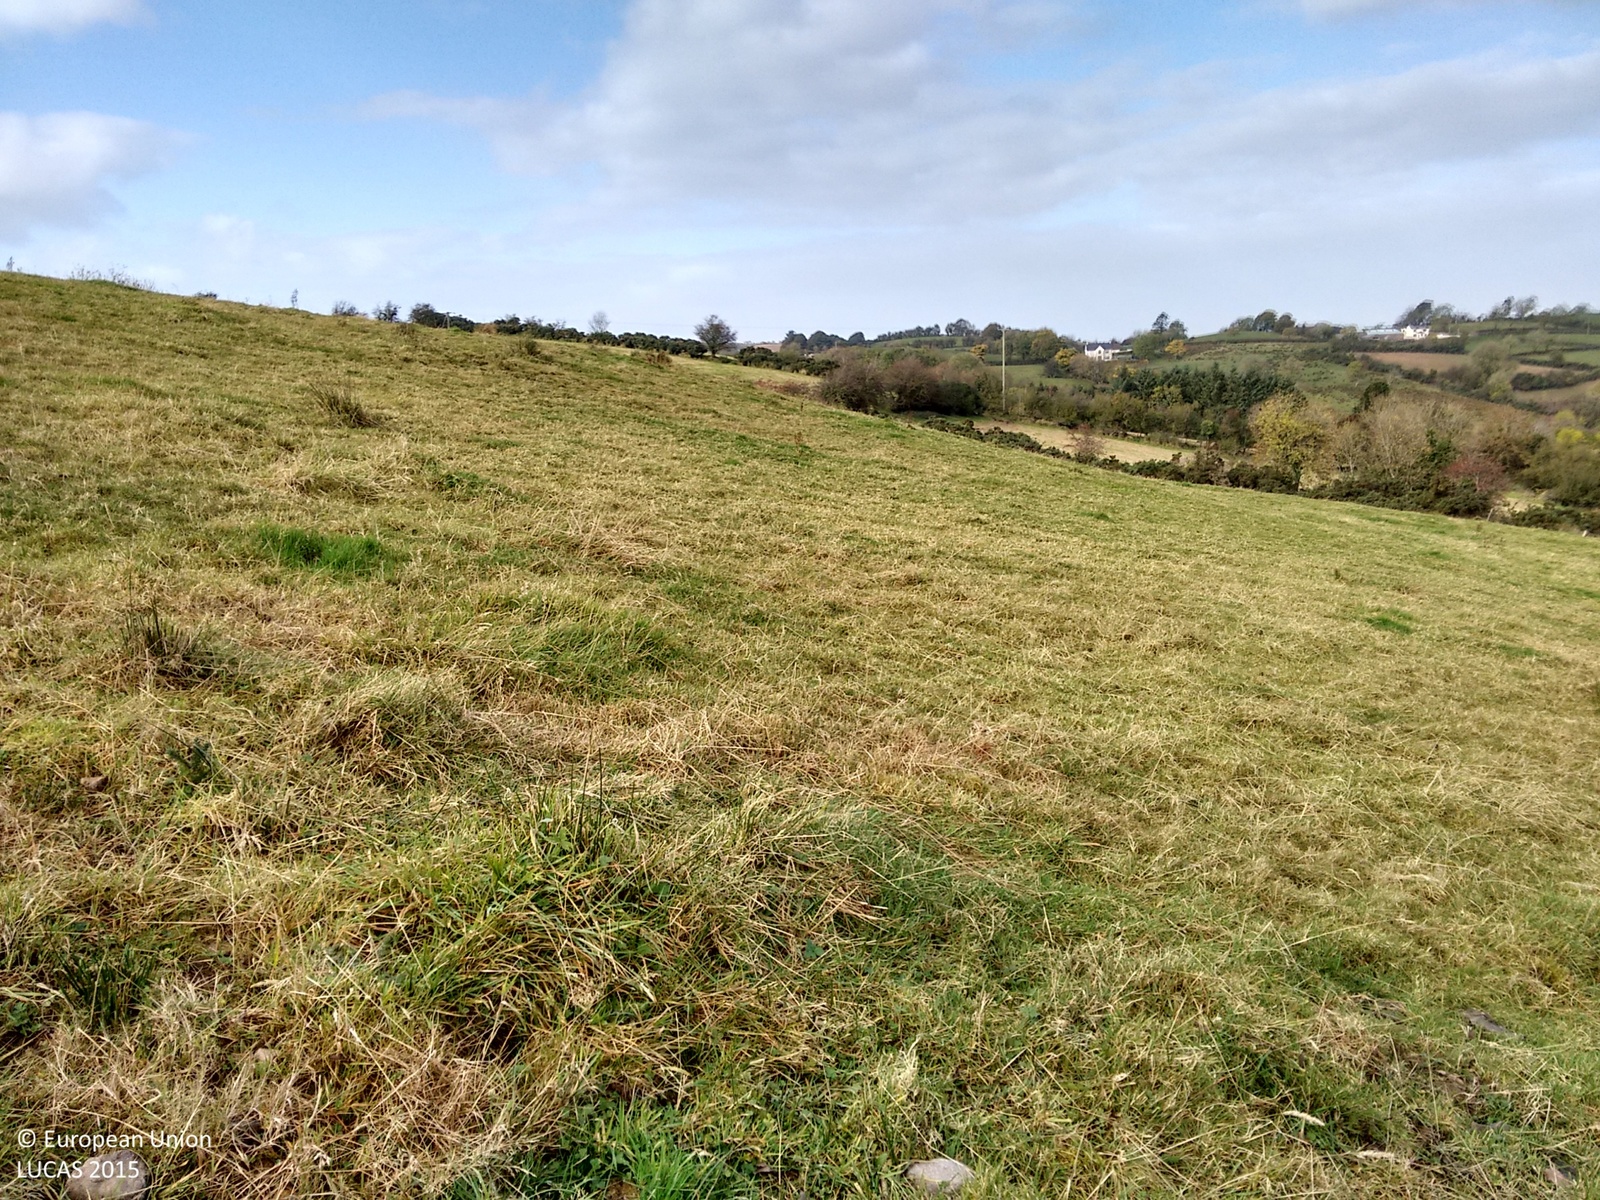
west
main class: Grassland
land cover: Grassland without tree/shrub cover
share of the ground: > 75 %
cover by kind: herbaceous plants 100 %
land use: Agriculture (excluding fallow land and kitchen gardens)
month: October
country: GB
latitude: 54.4526
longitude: -7.3800
